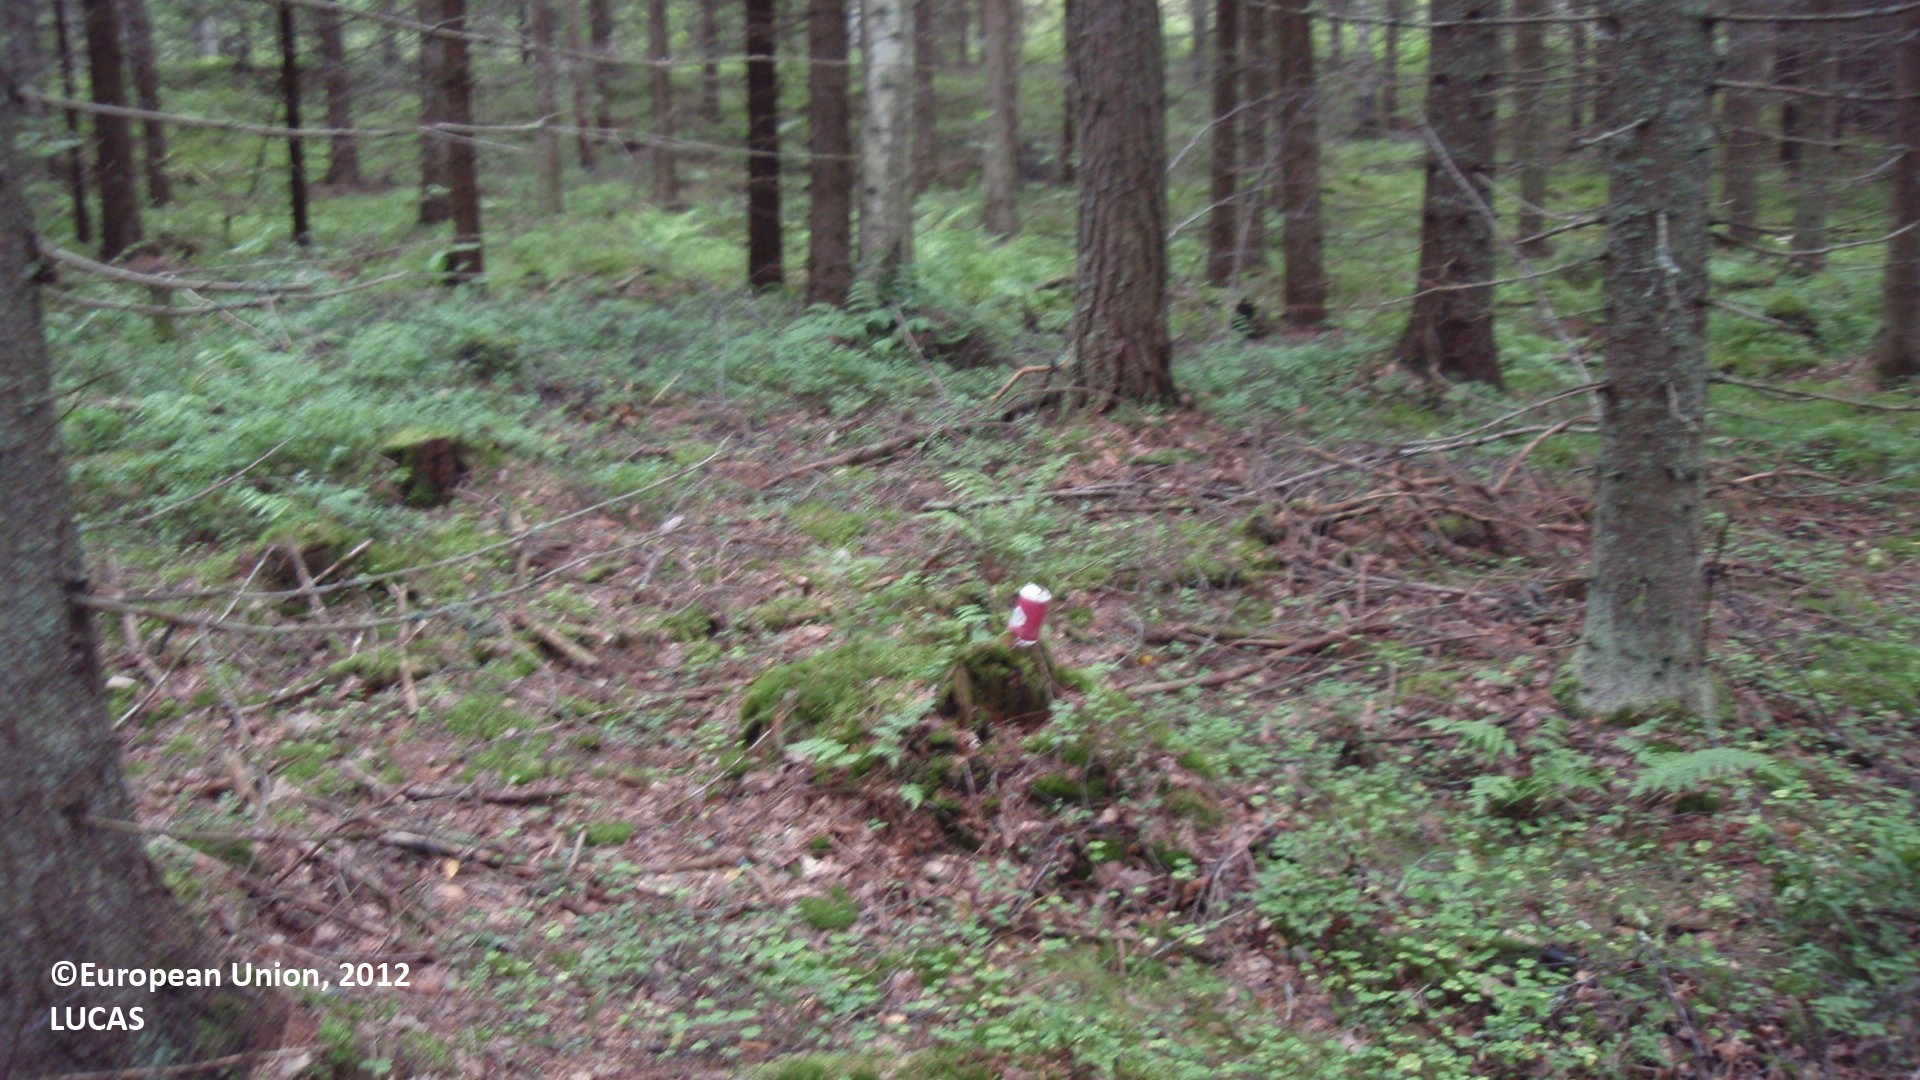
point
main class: Woodland
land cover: Spruce dominated mixed woodland
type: boreal forest
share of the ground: 50 - 75 %
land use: Forestry
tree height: > 5 m
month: August
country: FI
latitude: 61.1930
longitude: 27.7315
